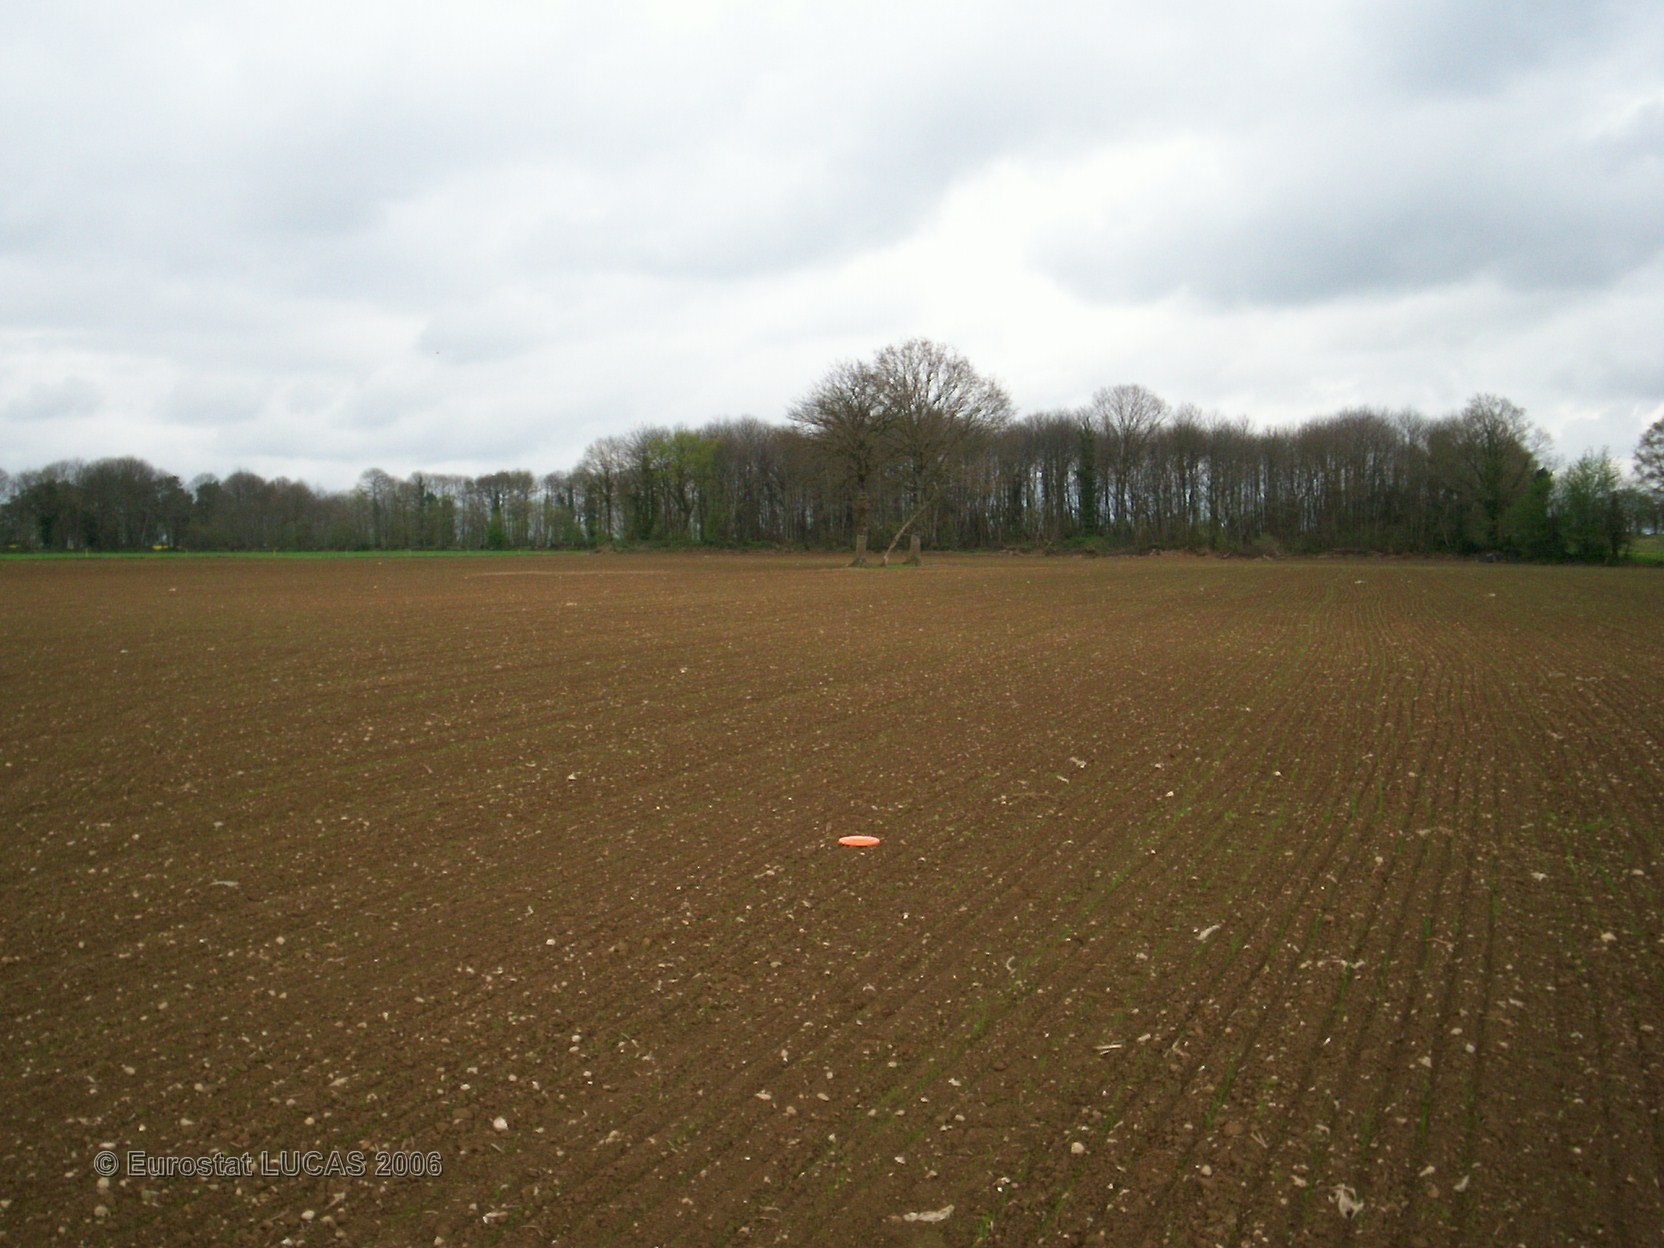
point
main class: Grassland
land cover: Grassland without tree/shrub cover
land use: Agriculture (excluding fallow land and kitchen gardens)
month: April
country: FR
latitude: 48.1028
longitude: -2.3999
